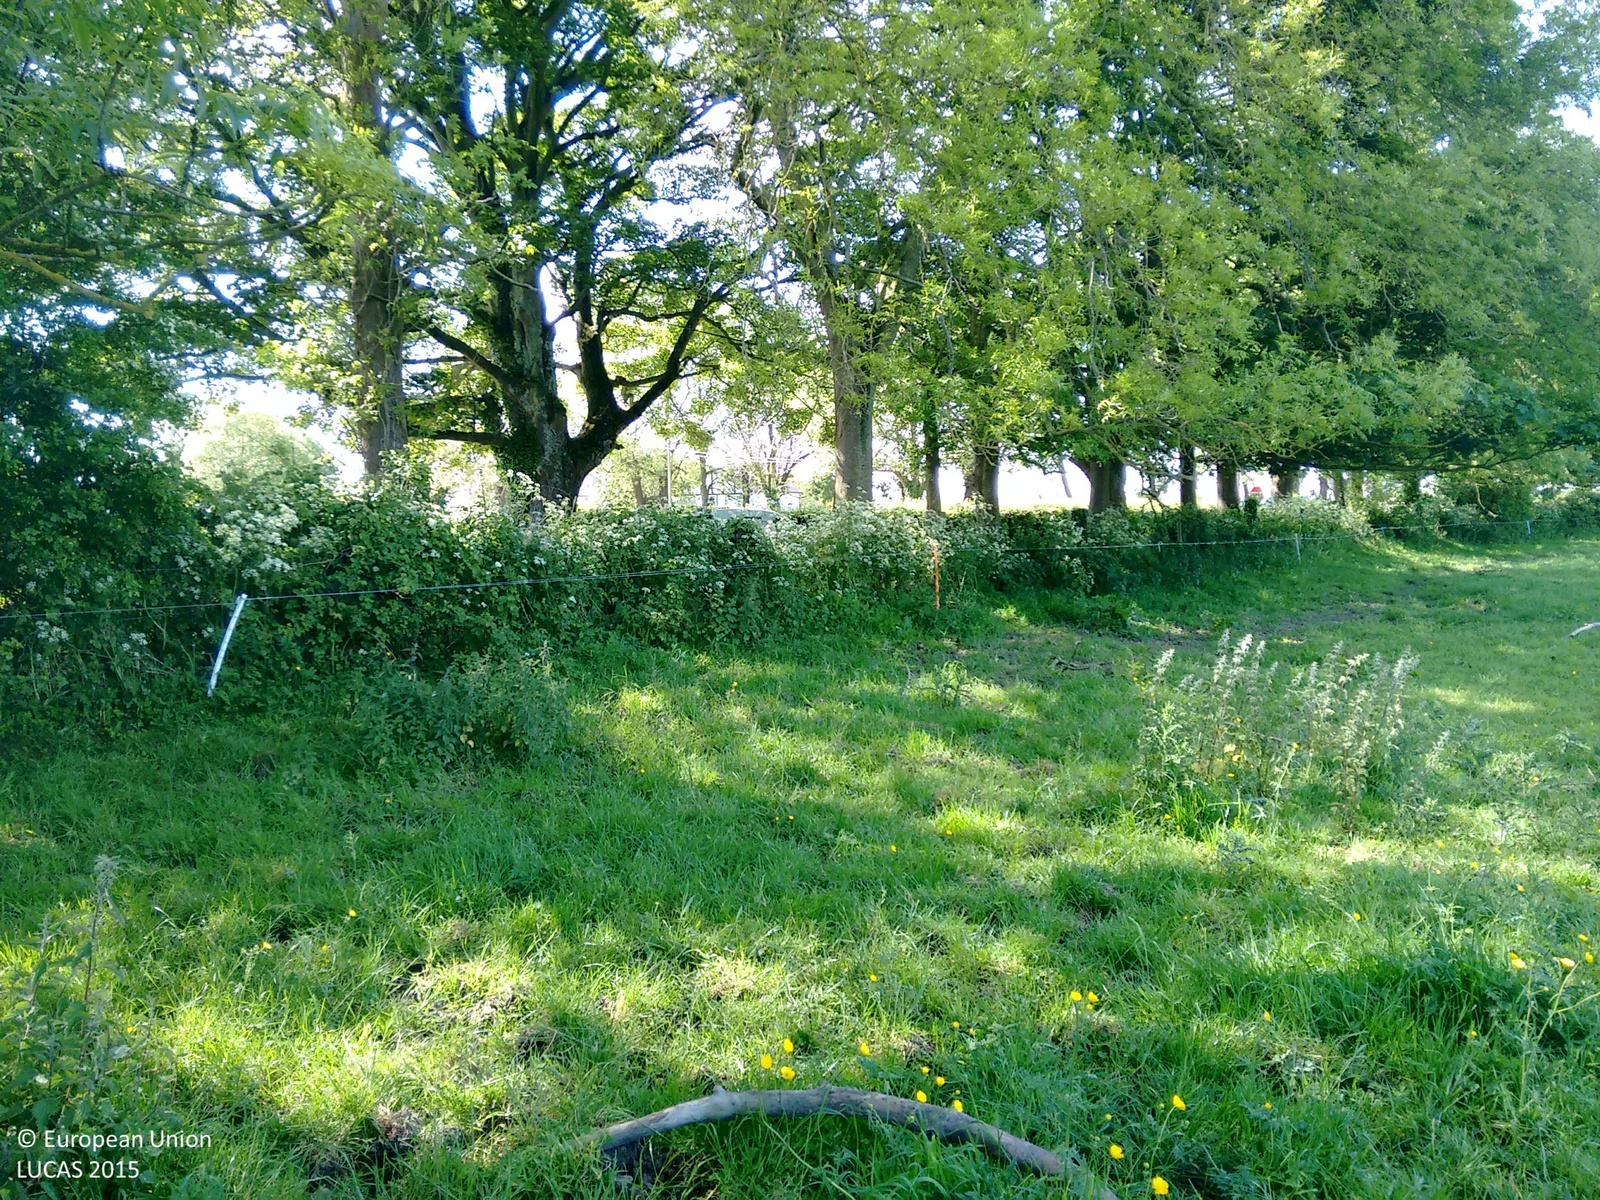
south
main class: Grassland
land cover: Grassland without tree/shrub cover
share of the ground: > 75 %
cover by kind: herbaceous plants 90 %, unconsolidated bare surface 10 %
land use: Agriculture (excluding fallow land and kitchen gardens)
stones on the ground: < 10 %
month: June
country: IE
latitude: 53.4363
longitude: -6.4889
